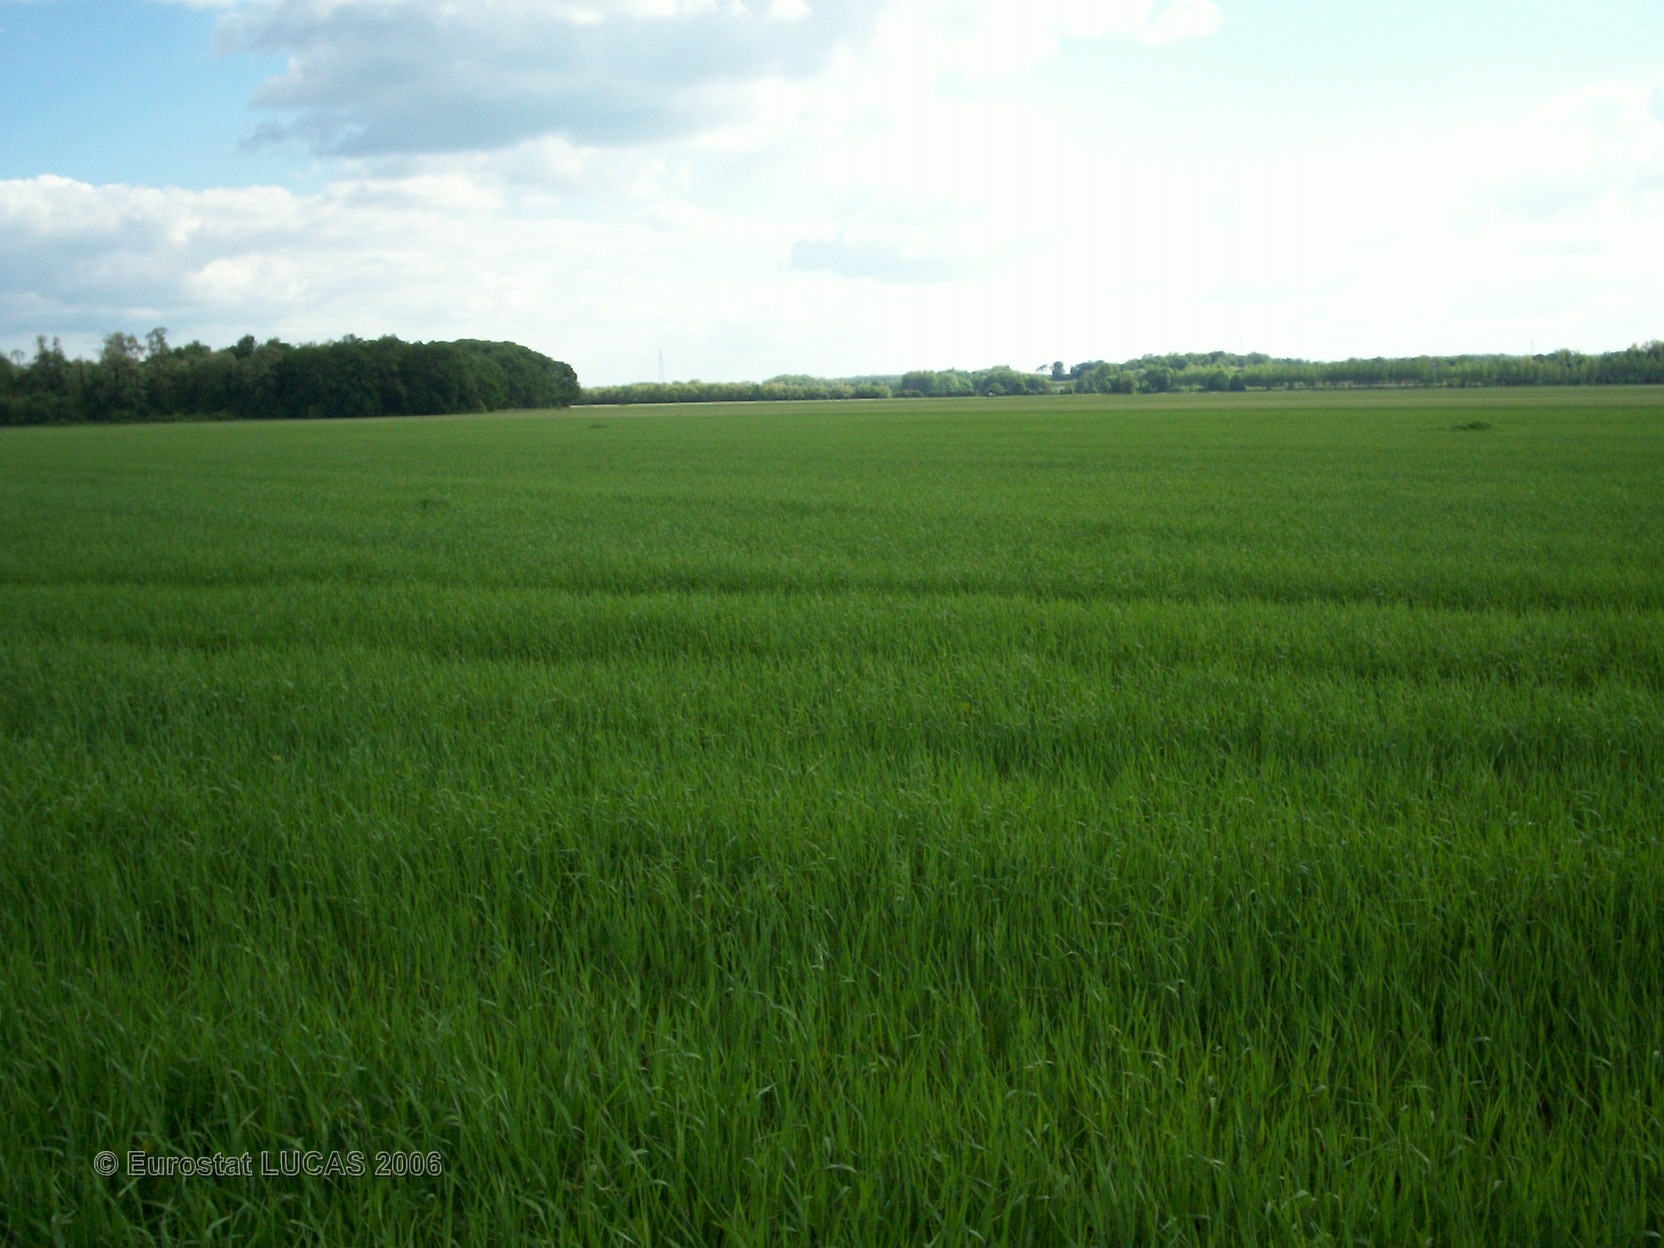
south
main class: Cropland
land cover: Barley
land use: Agriculture (excluding fallow land and kitchen gardens)
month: June
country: FR
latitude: 47.1172
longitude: 3.0232
